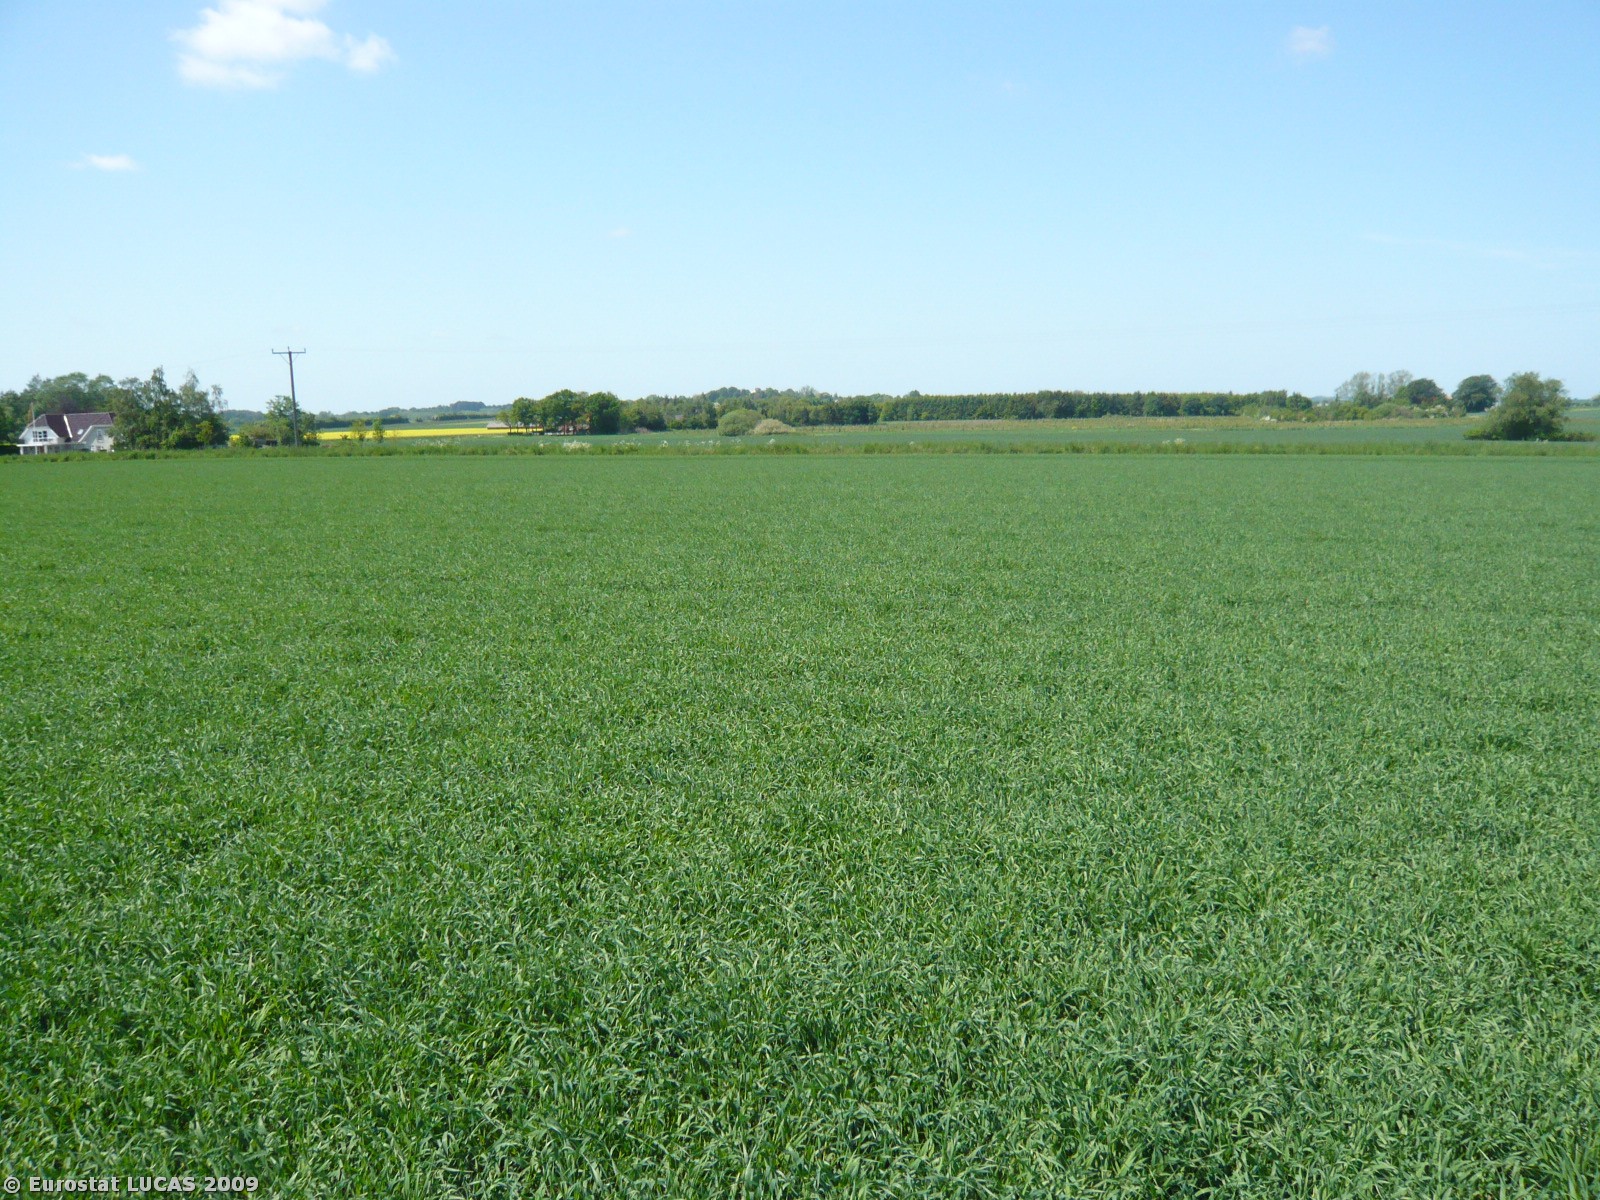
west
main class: Cropland
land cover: Barley
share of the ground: > 75 %
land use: Agriculture (excluding fallow land and kitchen gardens)
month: May
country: DK
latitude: 55.3475
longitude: 11.8436
